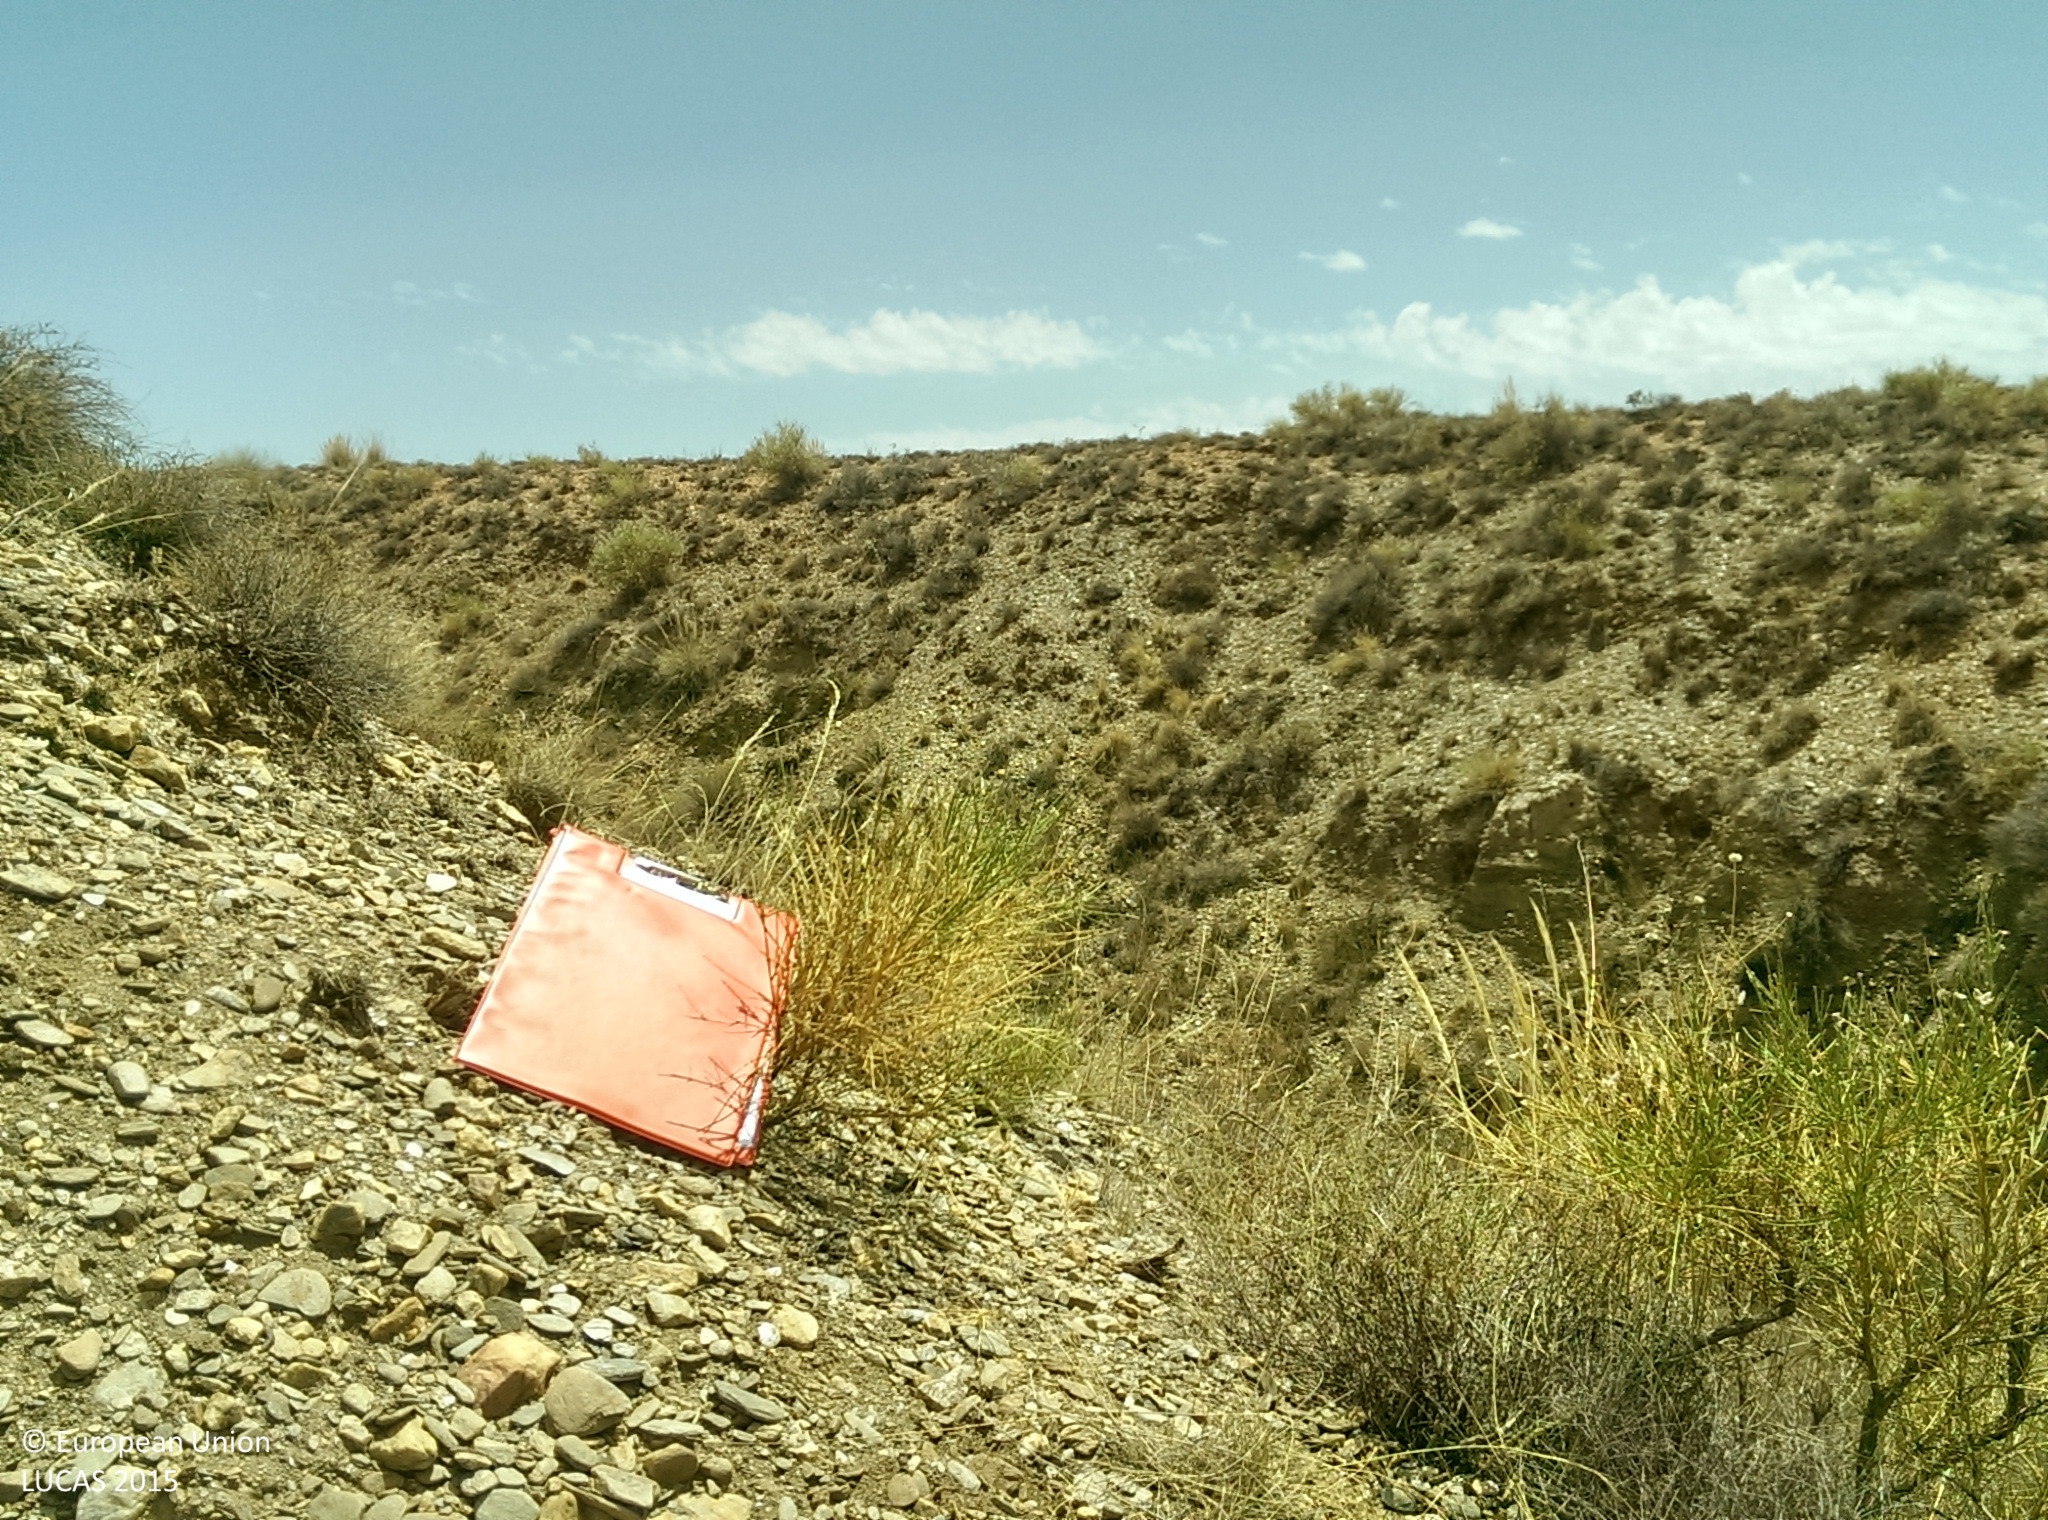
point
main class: Shrubland
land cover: Shrubland without tree cover
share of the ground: 25 - 50 %
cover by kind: shrubs 45 %, unconsolidated bare surface 35 %, herbaceous plants 20 %
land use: Semi-natural and natural areas not in use
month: July
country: ES
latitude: 37.2234
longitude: -3.0926
